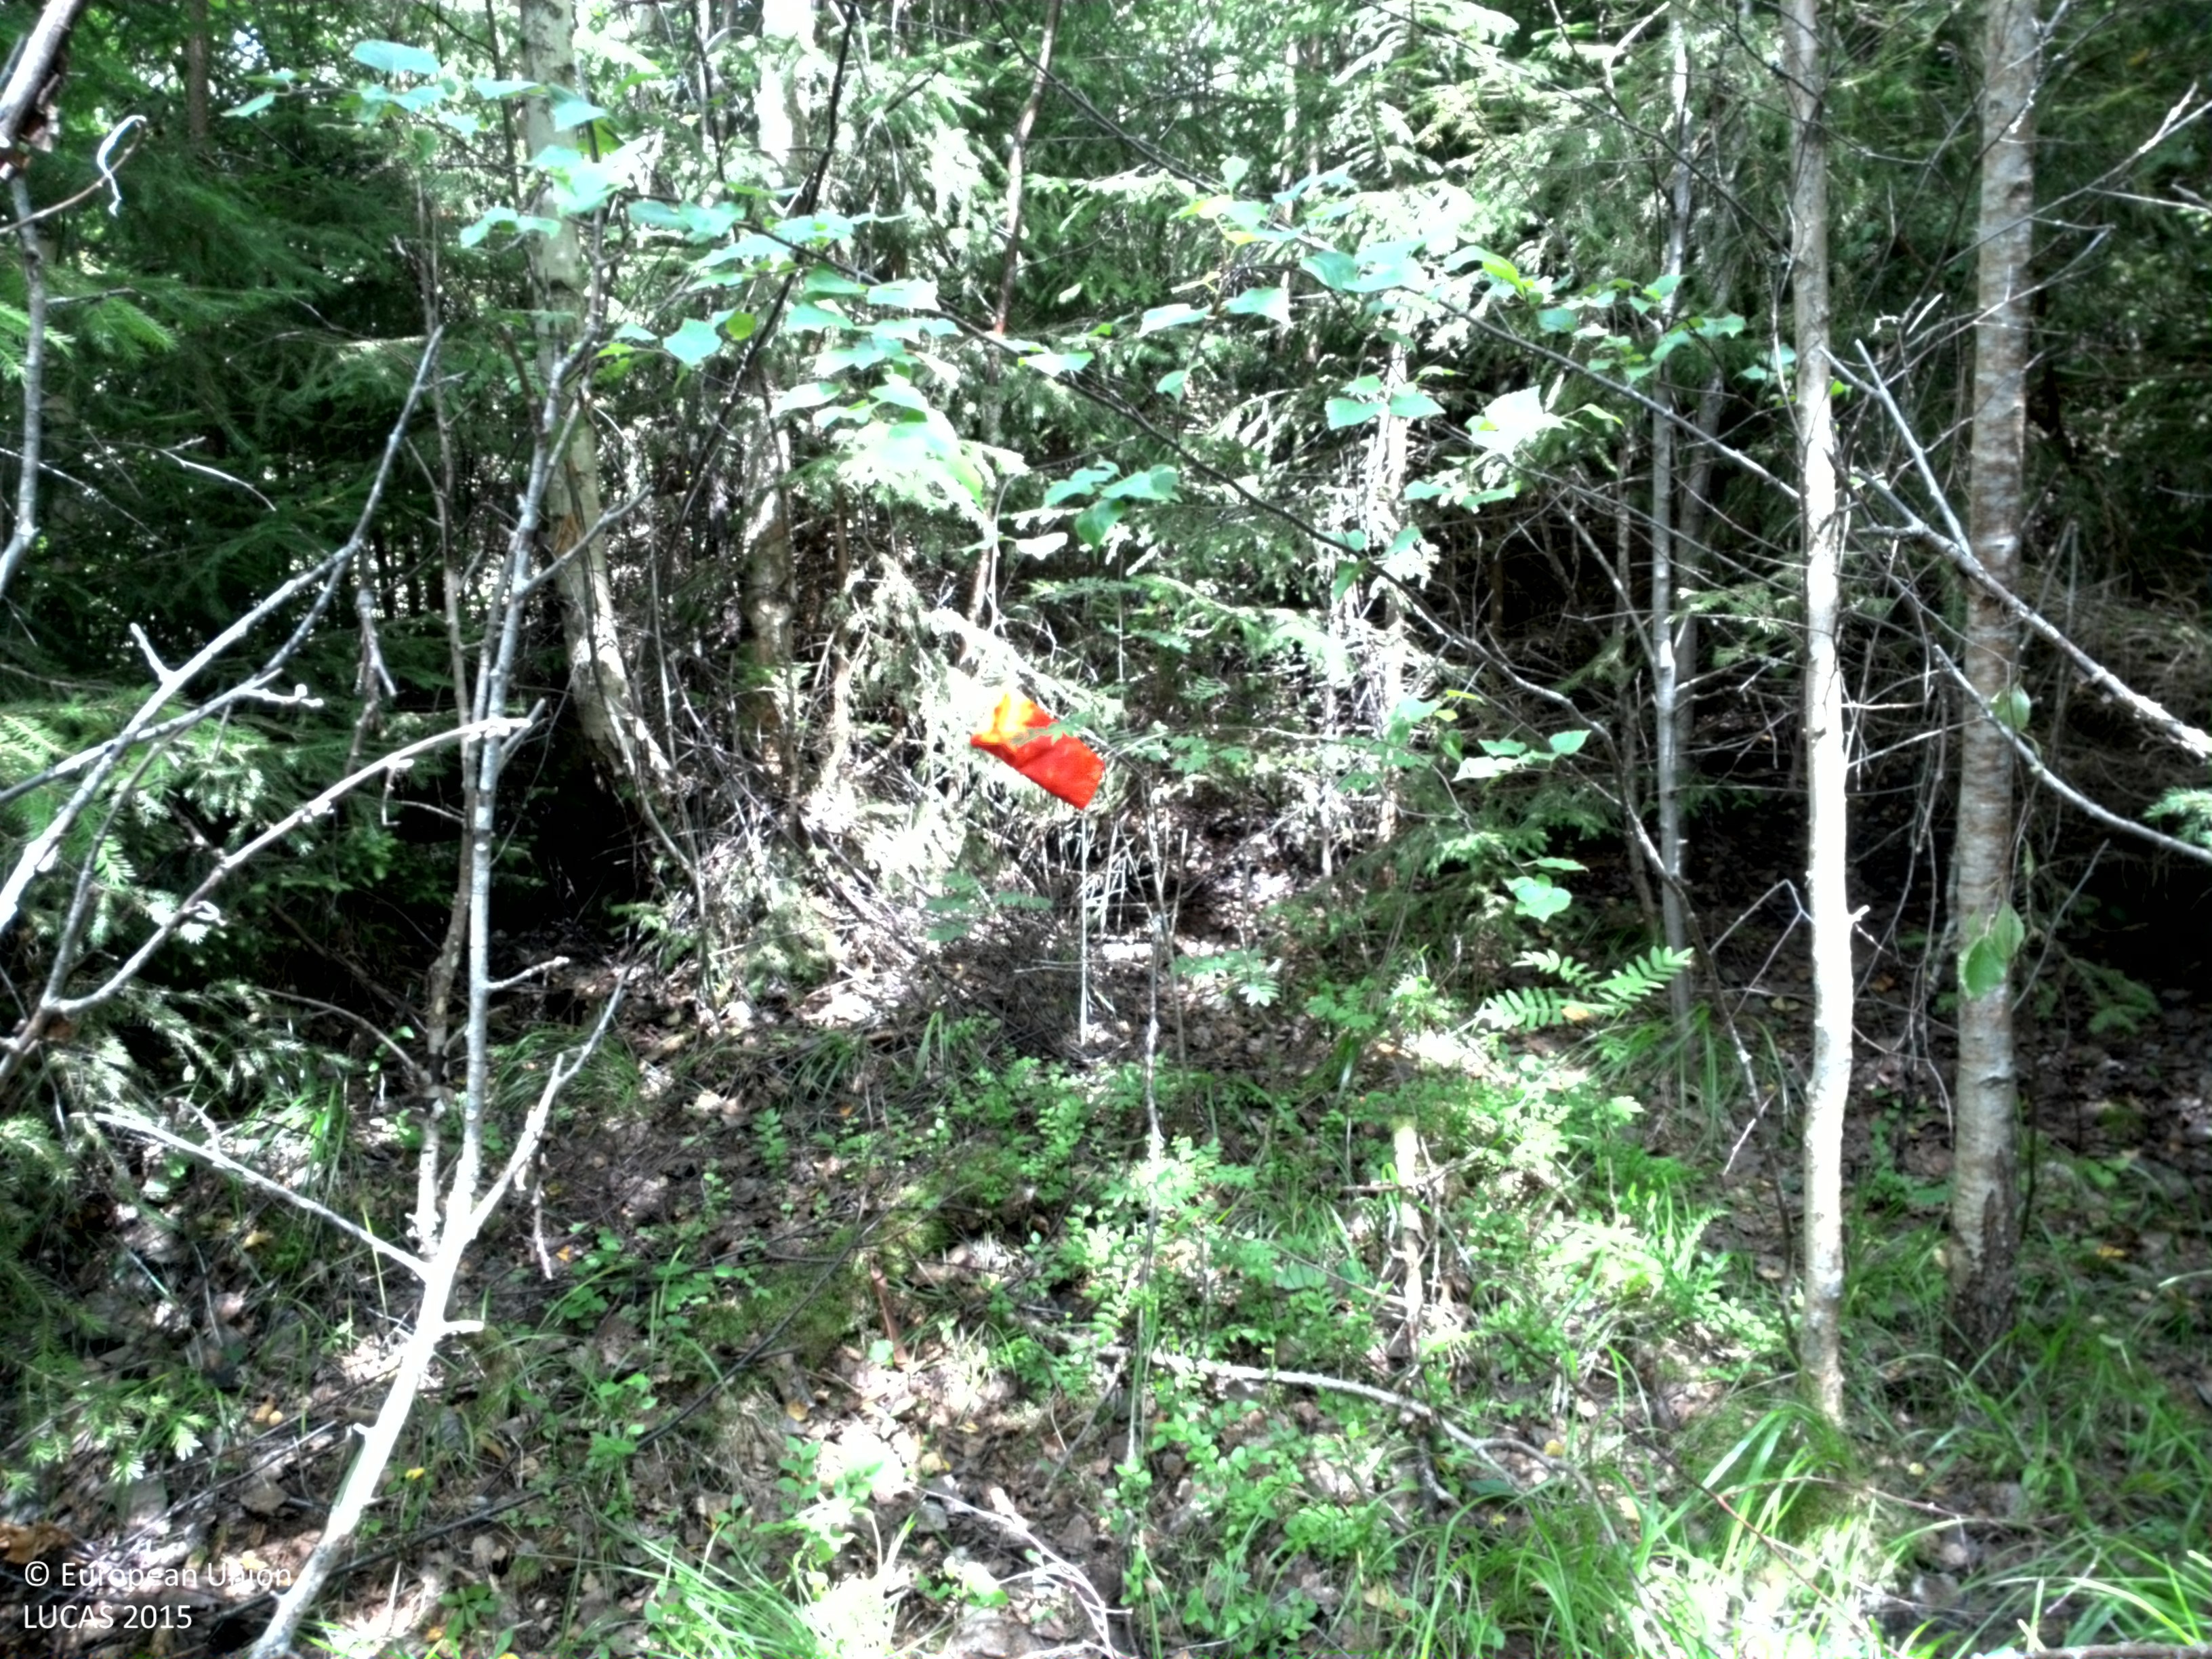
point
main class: Woodland
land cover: Spruce dominated mixed woodland
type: boreal forest
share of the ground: 50 - 75 %
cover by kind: coniferous forest trees 45 %, broadleaved forest trees 25 %, herbaceous plants 25 %, lichens and mosses 5 %
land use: Forestry
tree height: > 5 m
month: July
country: SE
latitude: 58.8274
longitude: 14.5481
